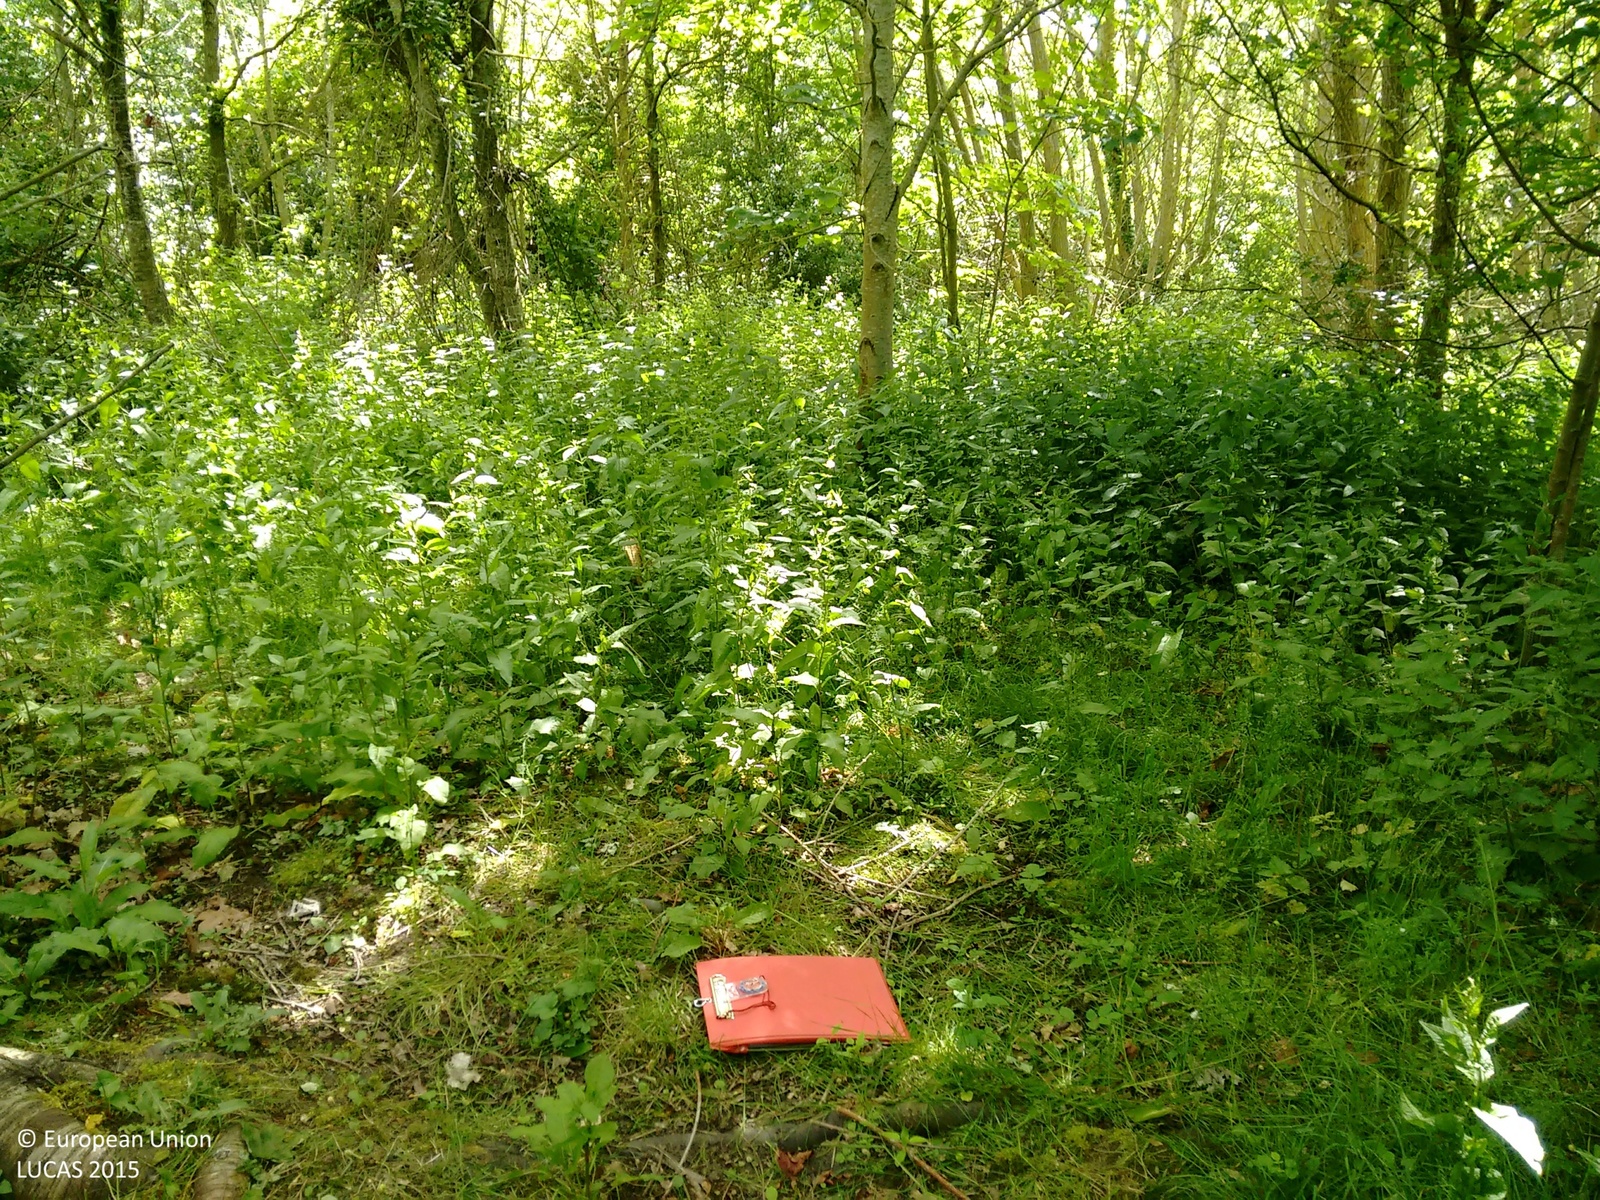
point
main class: Woodland
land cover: Broadleaved woodland
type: mesophytic deciduous forest
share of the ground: > 75 %
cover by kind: broadleaved forest trees 95 %, shrubs 5 %
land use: Forestry
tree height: > 5 m
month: June
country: GB
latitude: 52.0591
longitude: -1.6187
